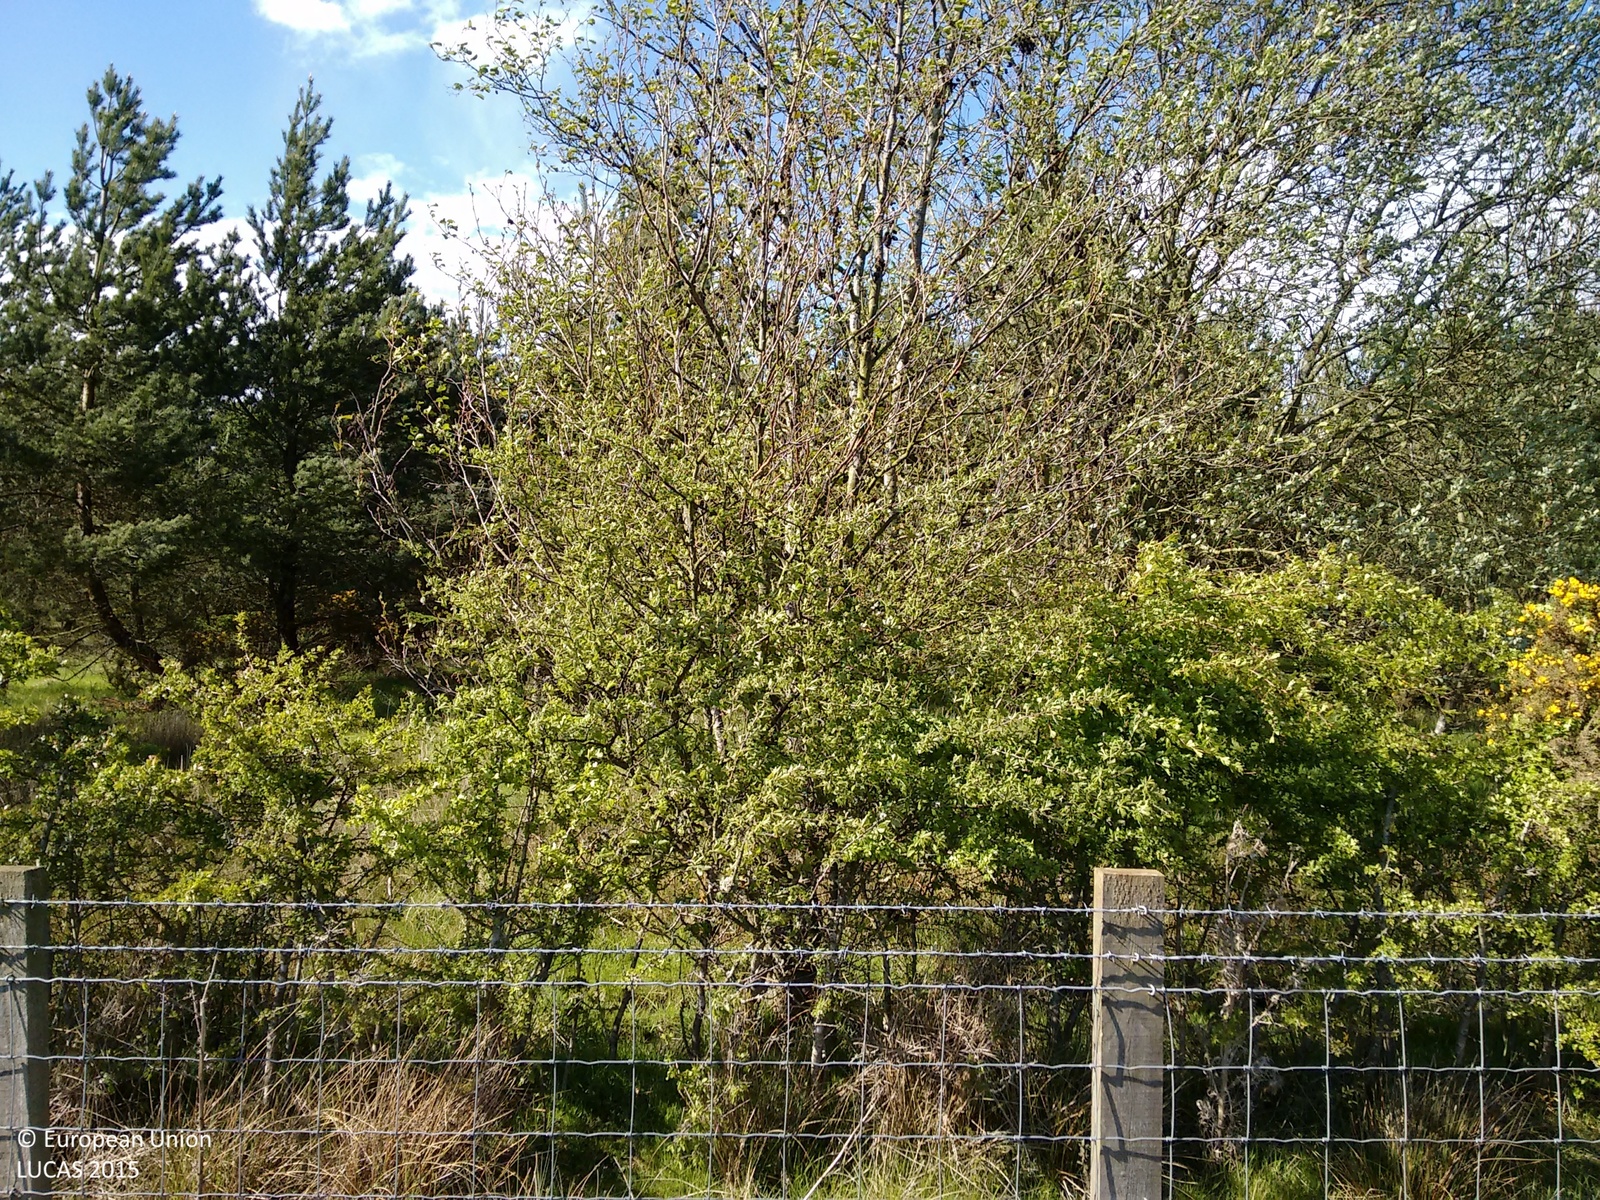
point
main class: Woodland
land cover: Pine dominated coniferous woodland
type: exotic forest
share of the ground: > 75 %
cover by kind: coniferous forest trees 100 %
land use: Forestry
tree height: > 5 m
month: May
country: GB
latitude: 55.1966
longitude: -1.6905
